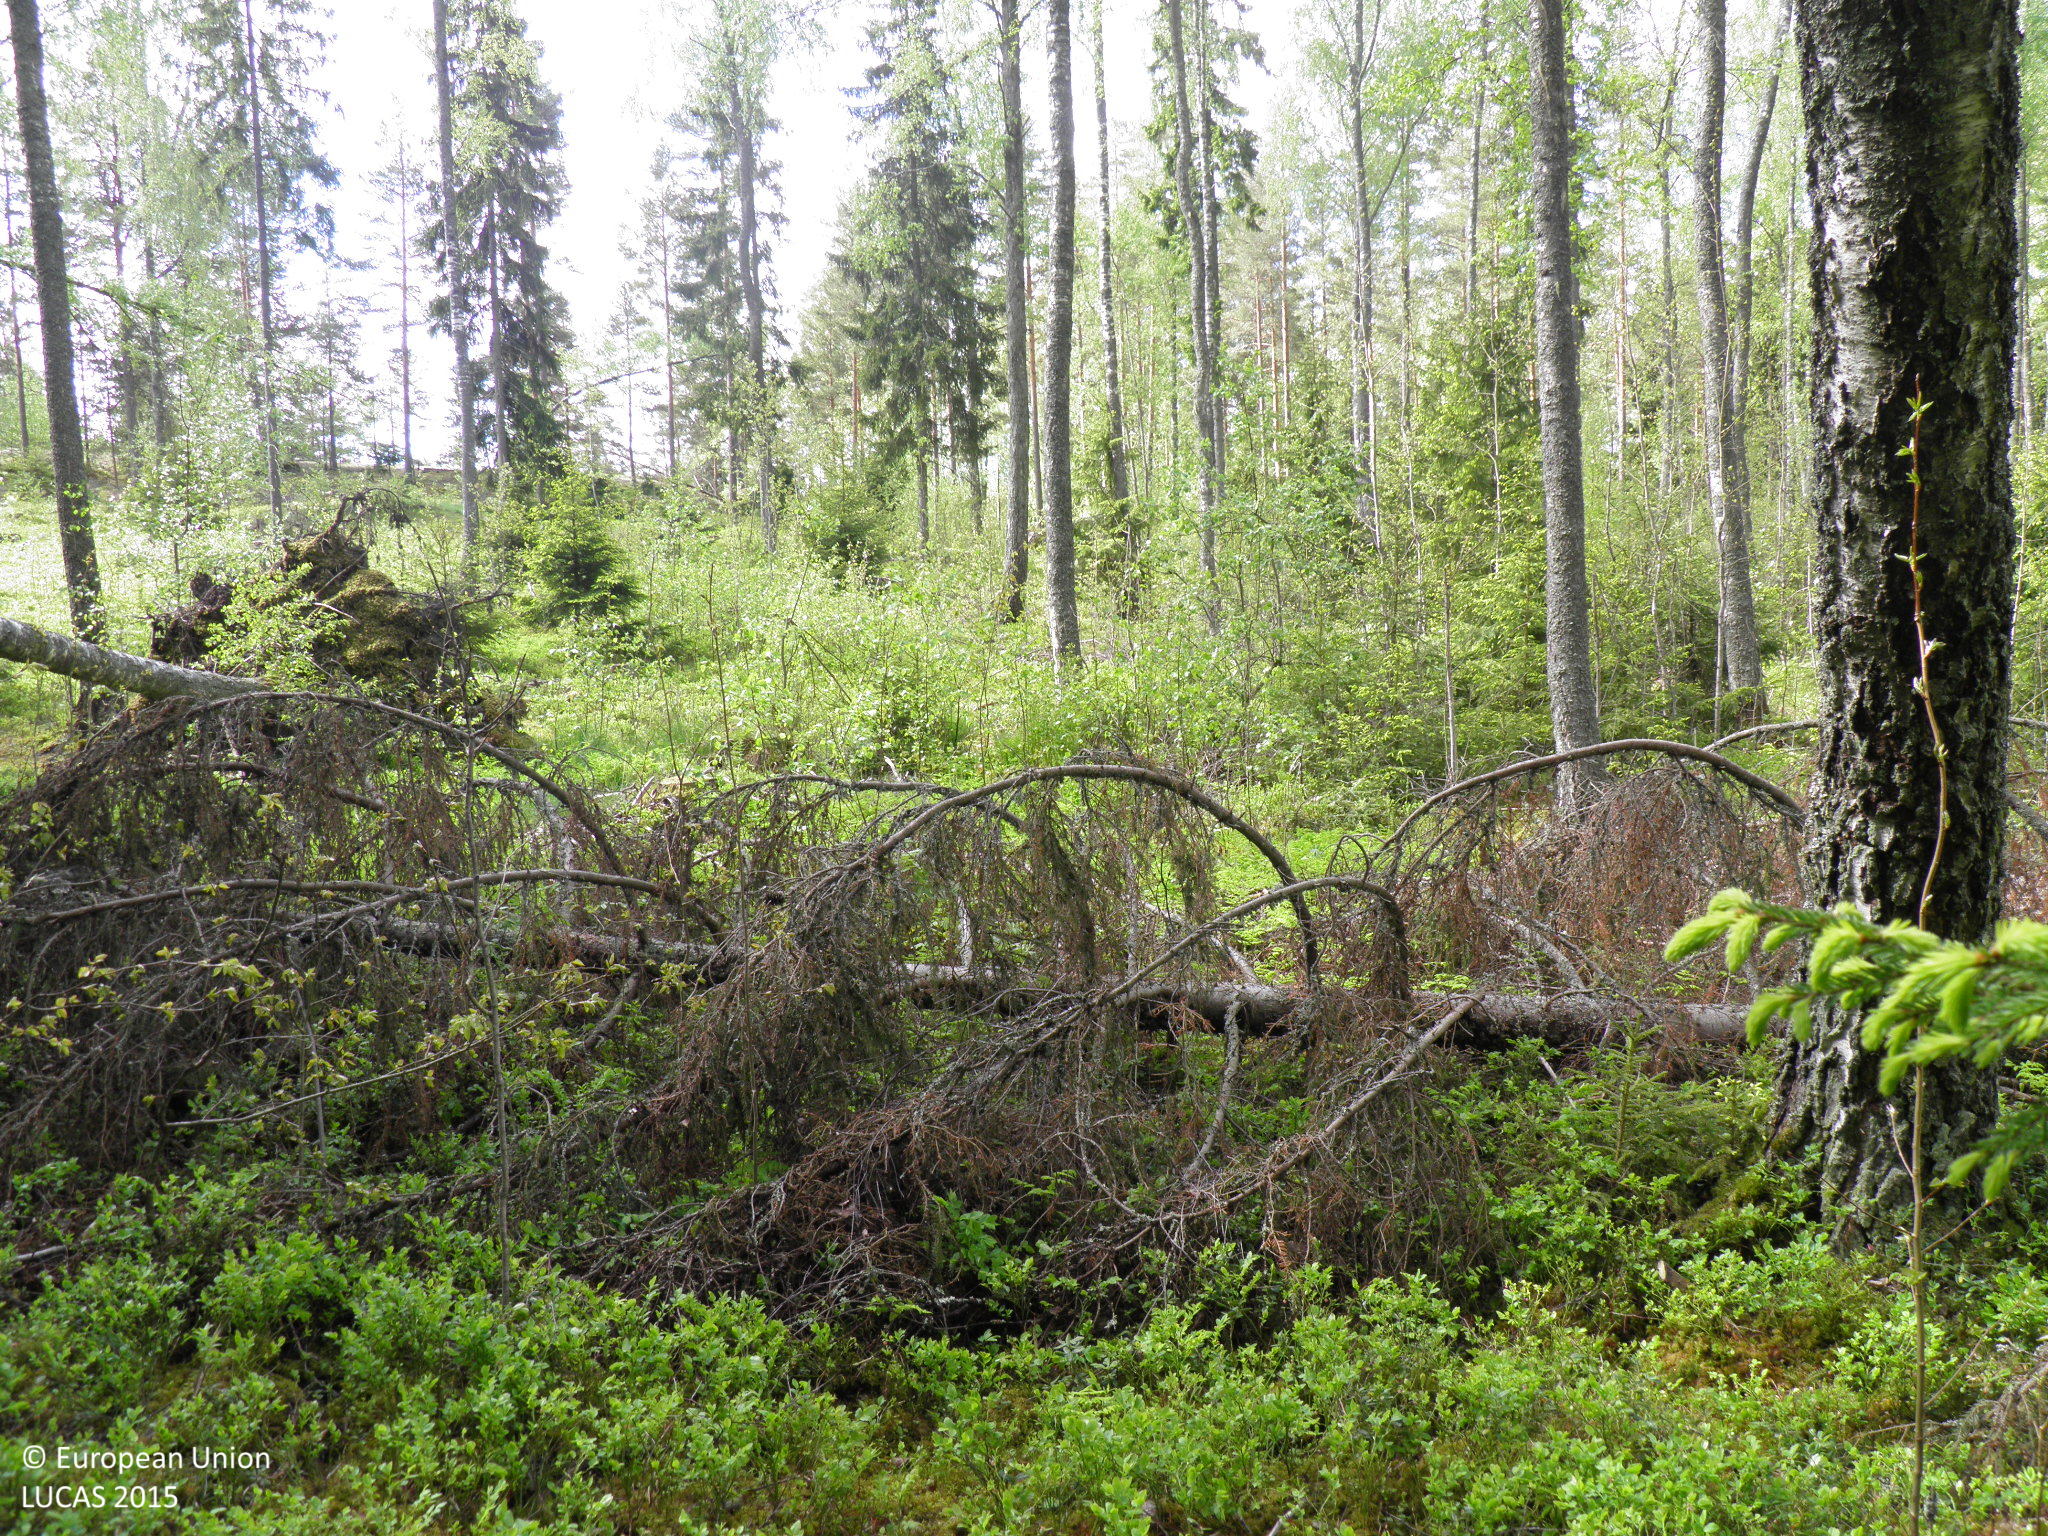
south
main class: Woodland
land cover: Spruce dominated mixed woodland
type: boreal forest
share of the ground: > 75 %
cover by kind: coniferous forest trees 65 %, broadleaved forest trees 25 %, shrubs 10 %
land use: Forestry
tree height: > 5 m
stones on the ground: < 10 %
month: May
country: FI
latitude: 60.3724
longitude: 22.2721
